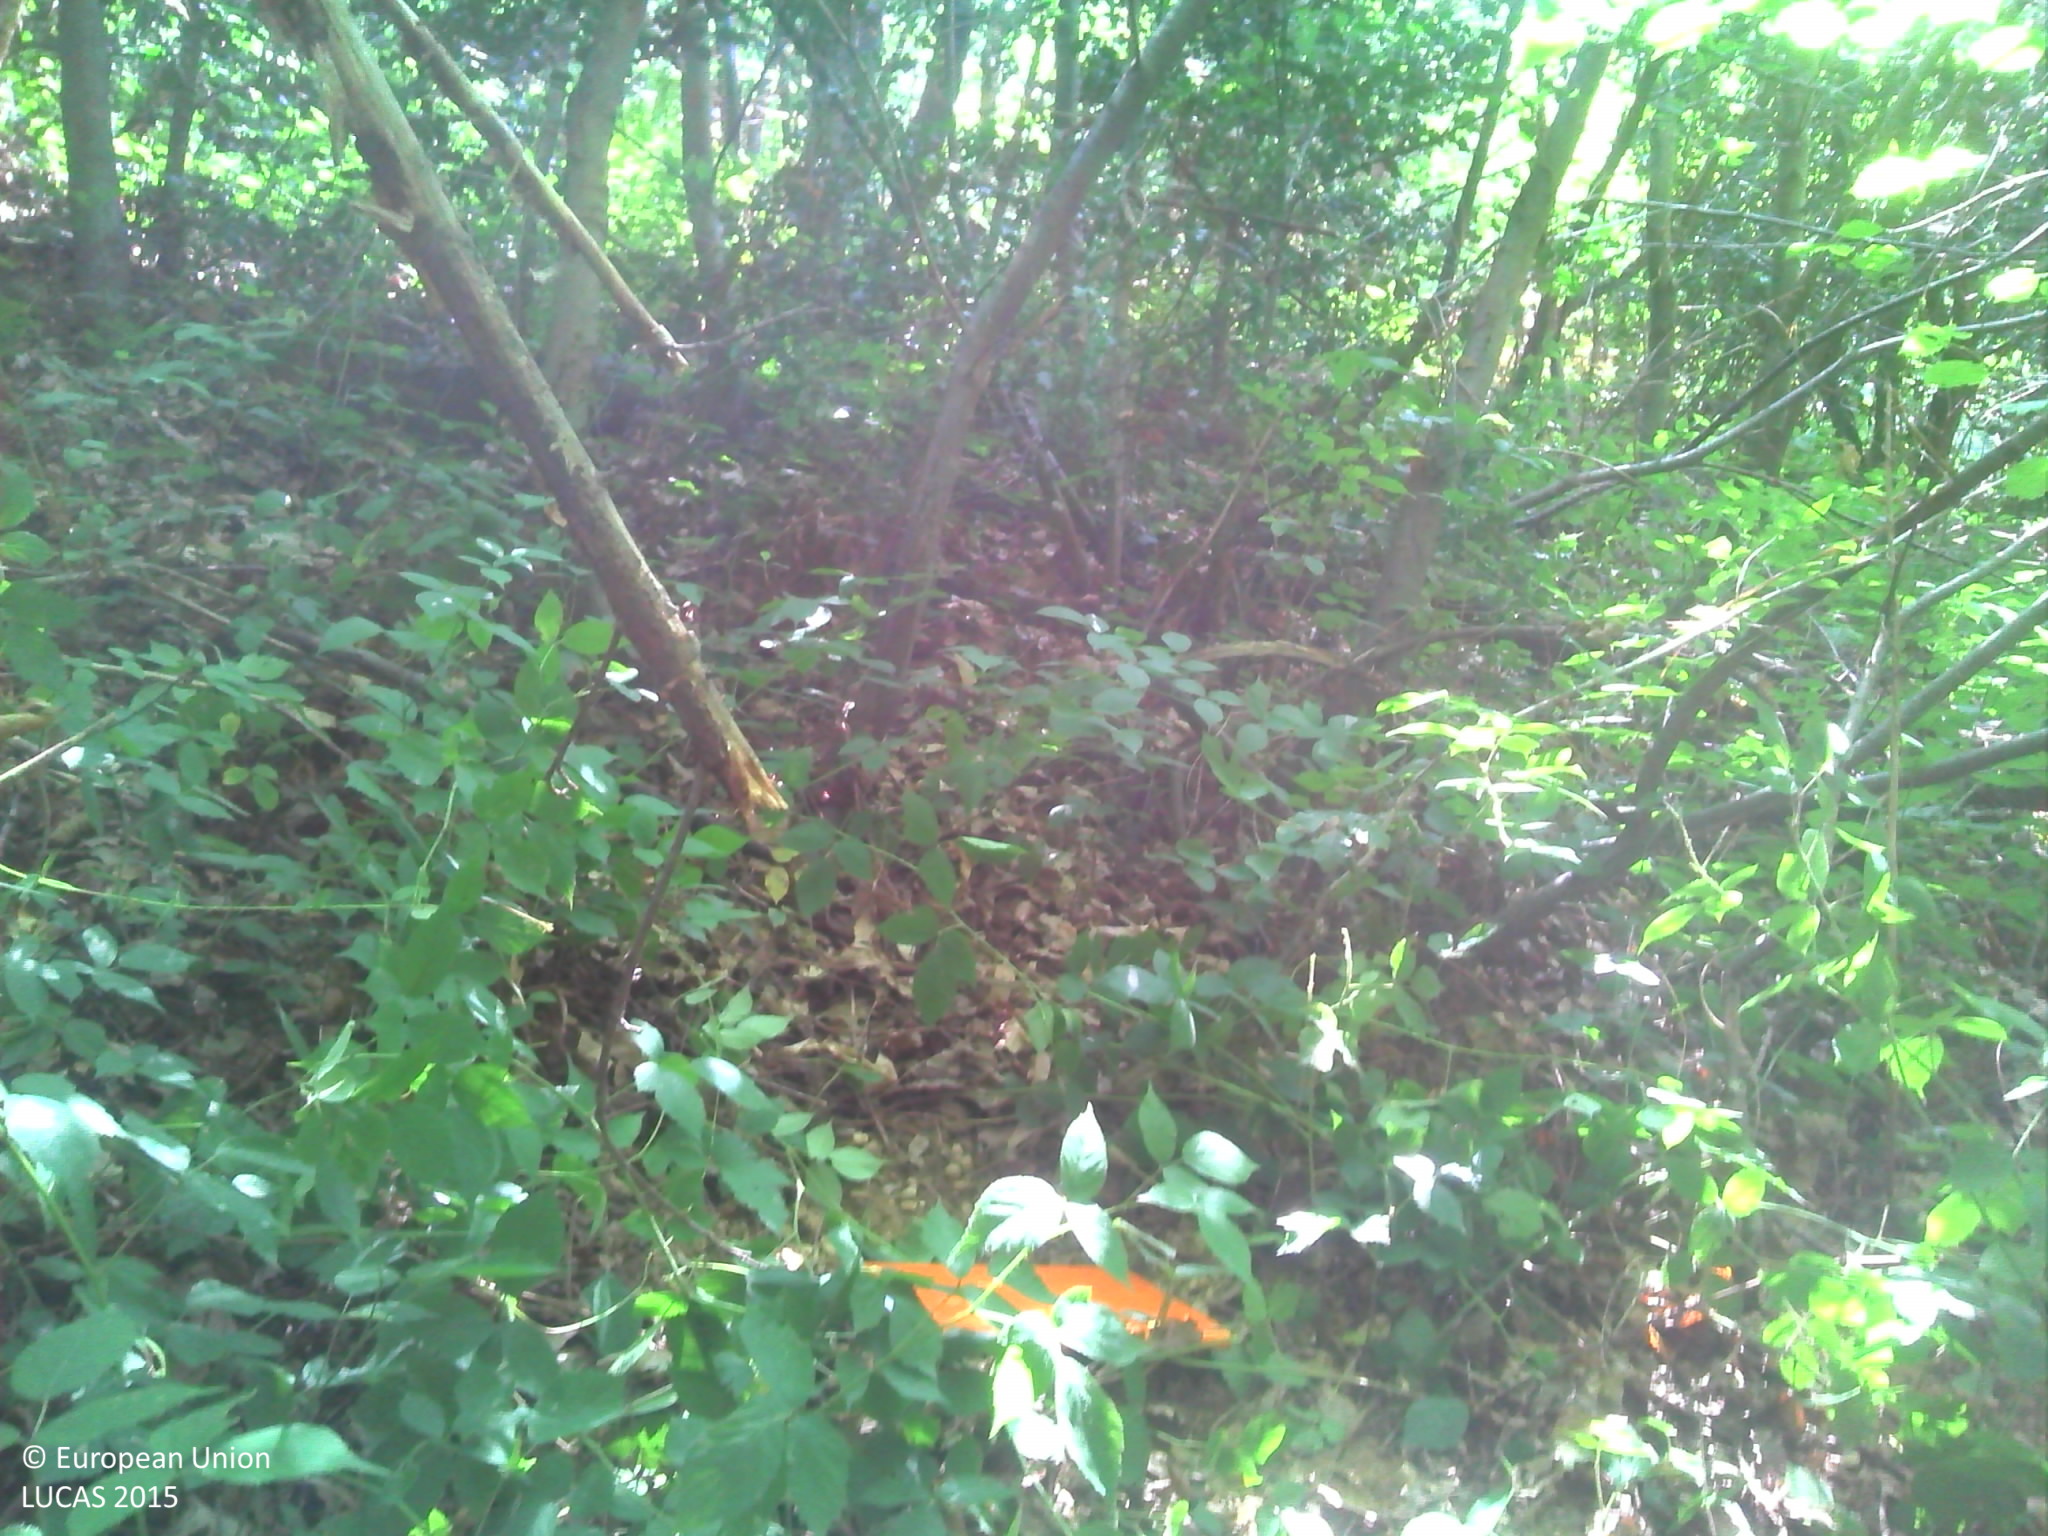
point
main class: Woodland
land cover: Broadleaved woodland
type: floodplain forest
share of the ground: > 75 %
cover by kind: broadleaved forest trees 95 %, coniferous forest trees 5 %
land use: Forestry
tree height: > 5 m
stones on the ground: 10 - 25 %
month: September
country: FR
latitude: 45.2318
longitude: 5.1777
